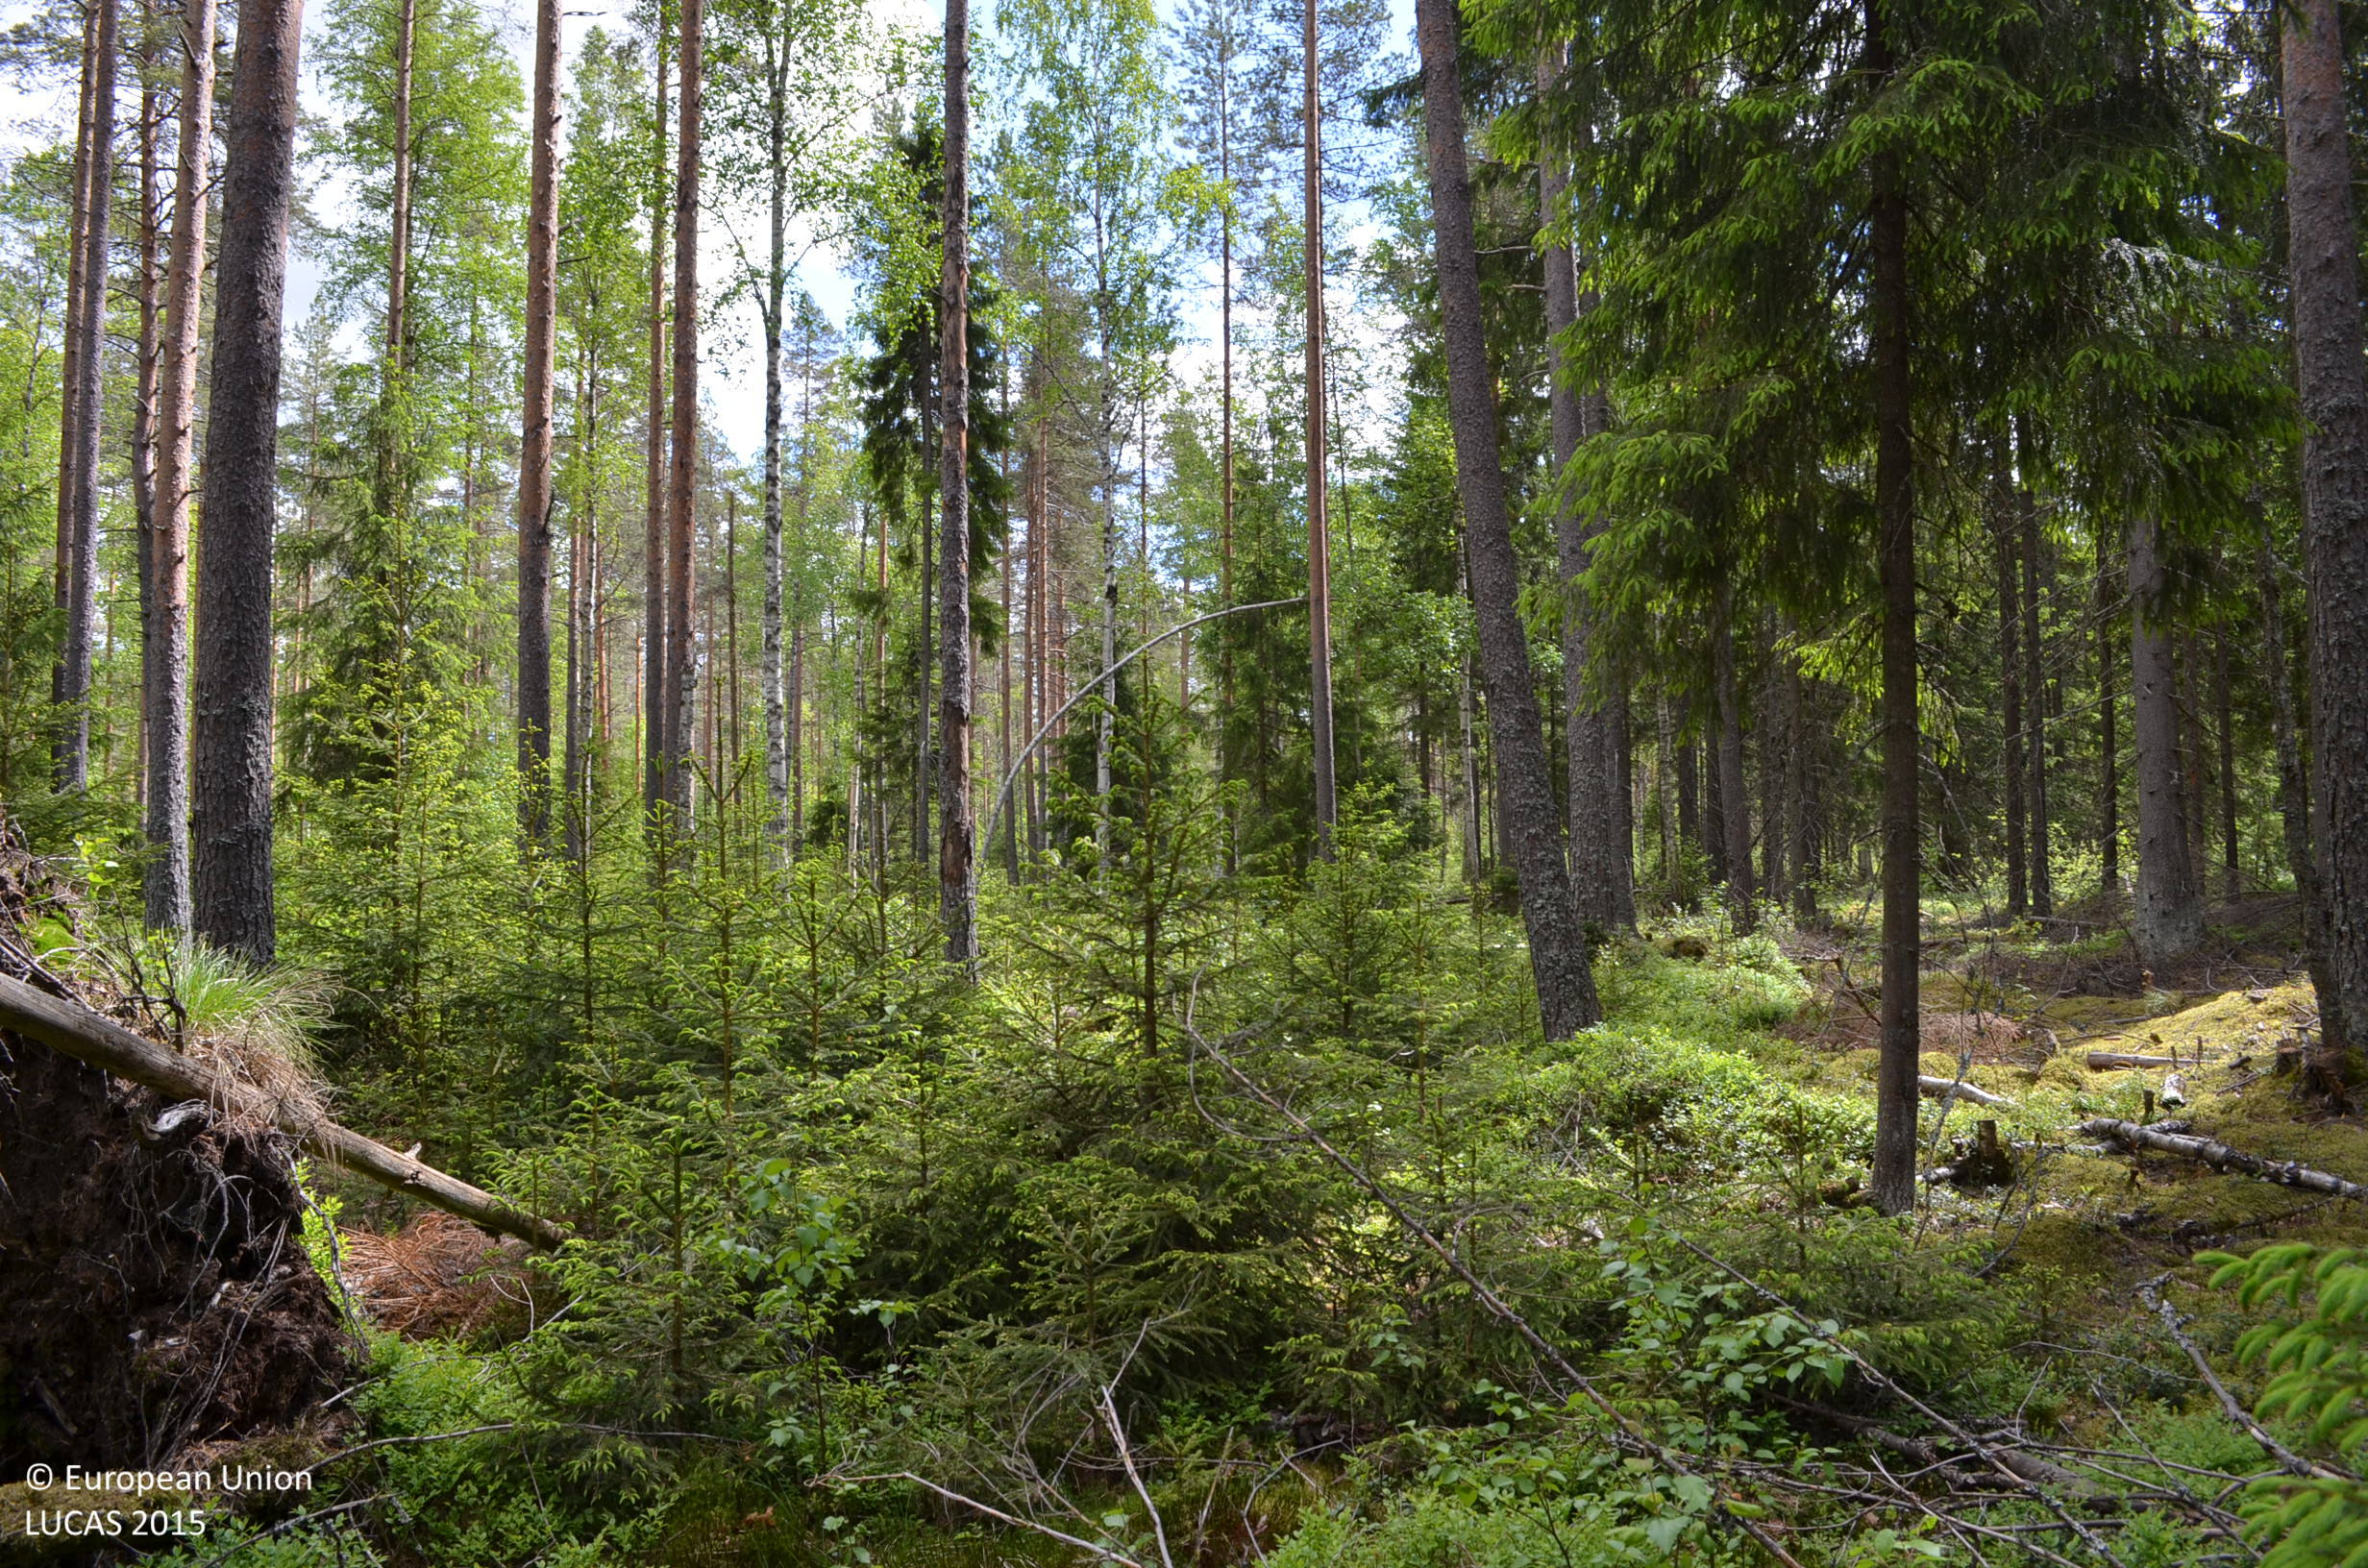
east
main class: Woodland
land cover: Other mixed woodland
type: boreal forest
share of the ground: > 75 %
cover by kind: coniferous forest trees 60 %, broadleaved forest trees 20 %, shrubs 20 %
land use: Forestry
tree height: > 5 m
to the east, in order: Other mixed woodland; Ditches and canals; Other mixed woodland; Ditches and canals; Other mixed woodland; Ditches and canals; Pine dominated coniferous woodland; Ditches and canals; Pine dominated coniferous woodland; Ditches and canals; Pine dominated coniferous woodland; Ditches and canals; Pine dominated coniferous woodland
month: June
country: FI
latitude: 61.9759
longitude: 23.3712
